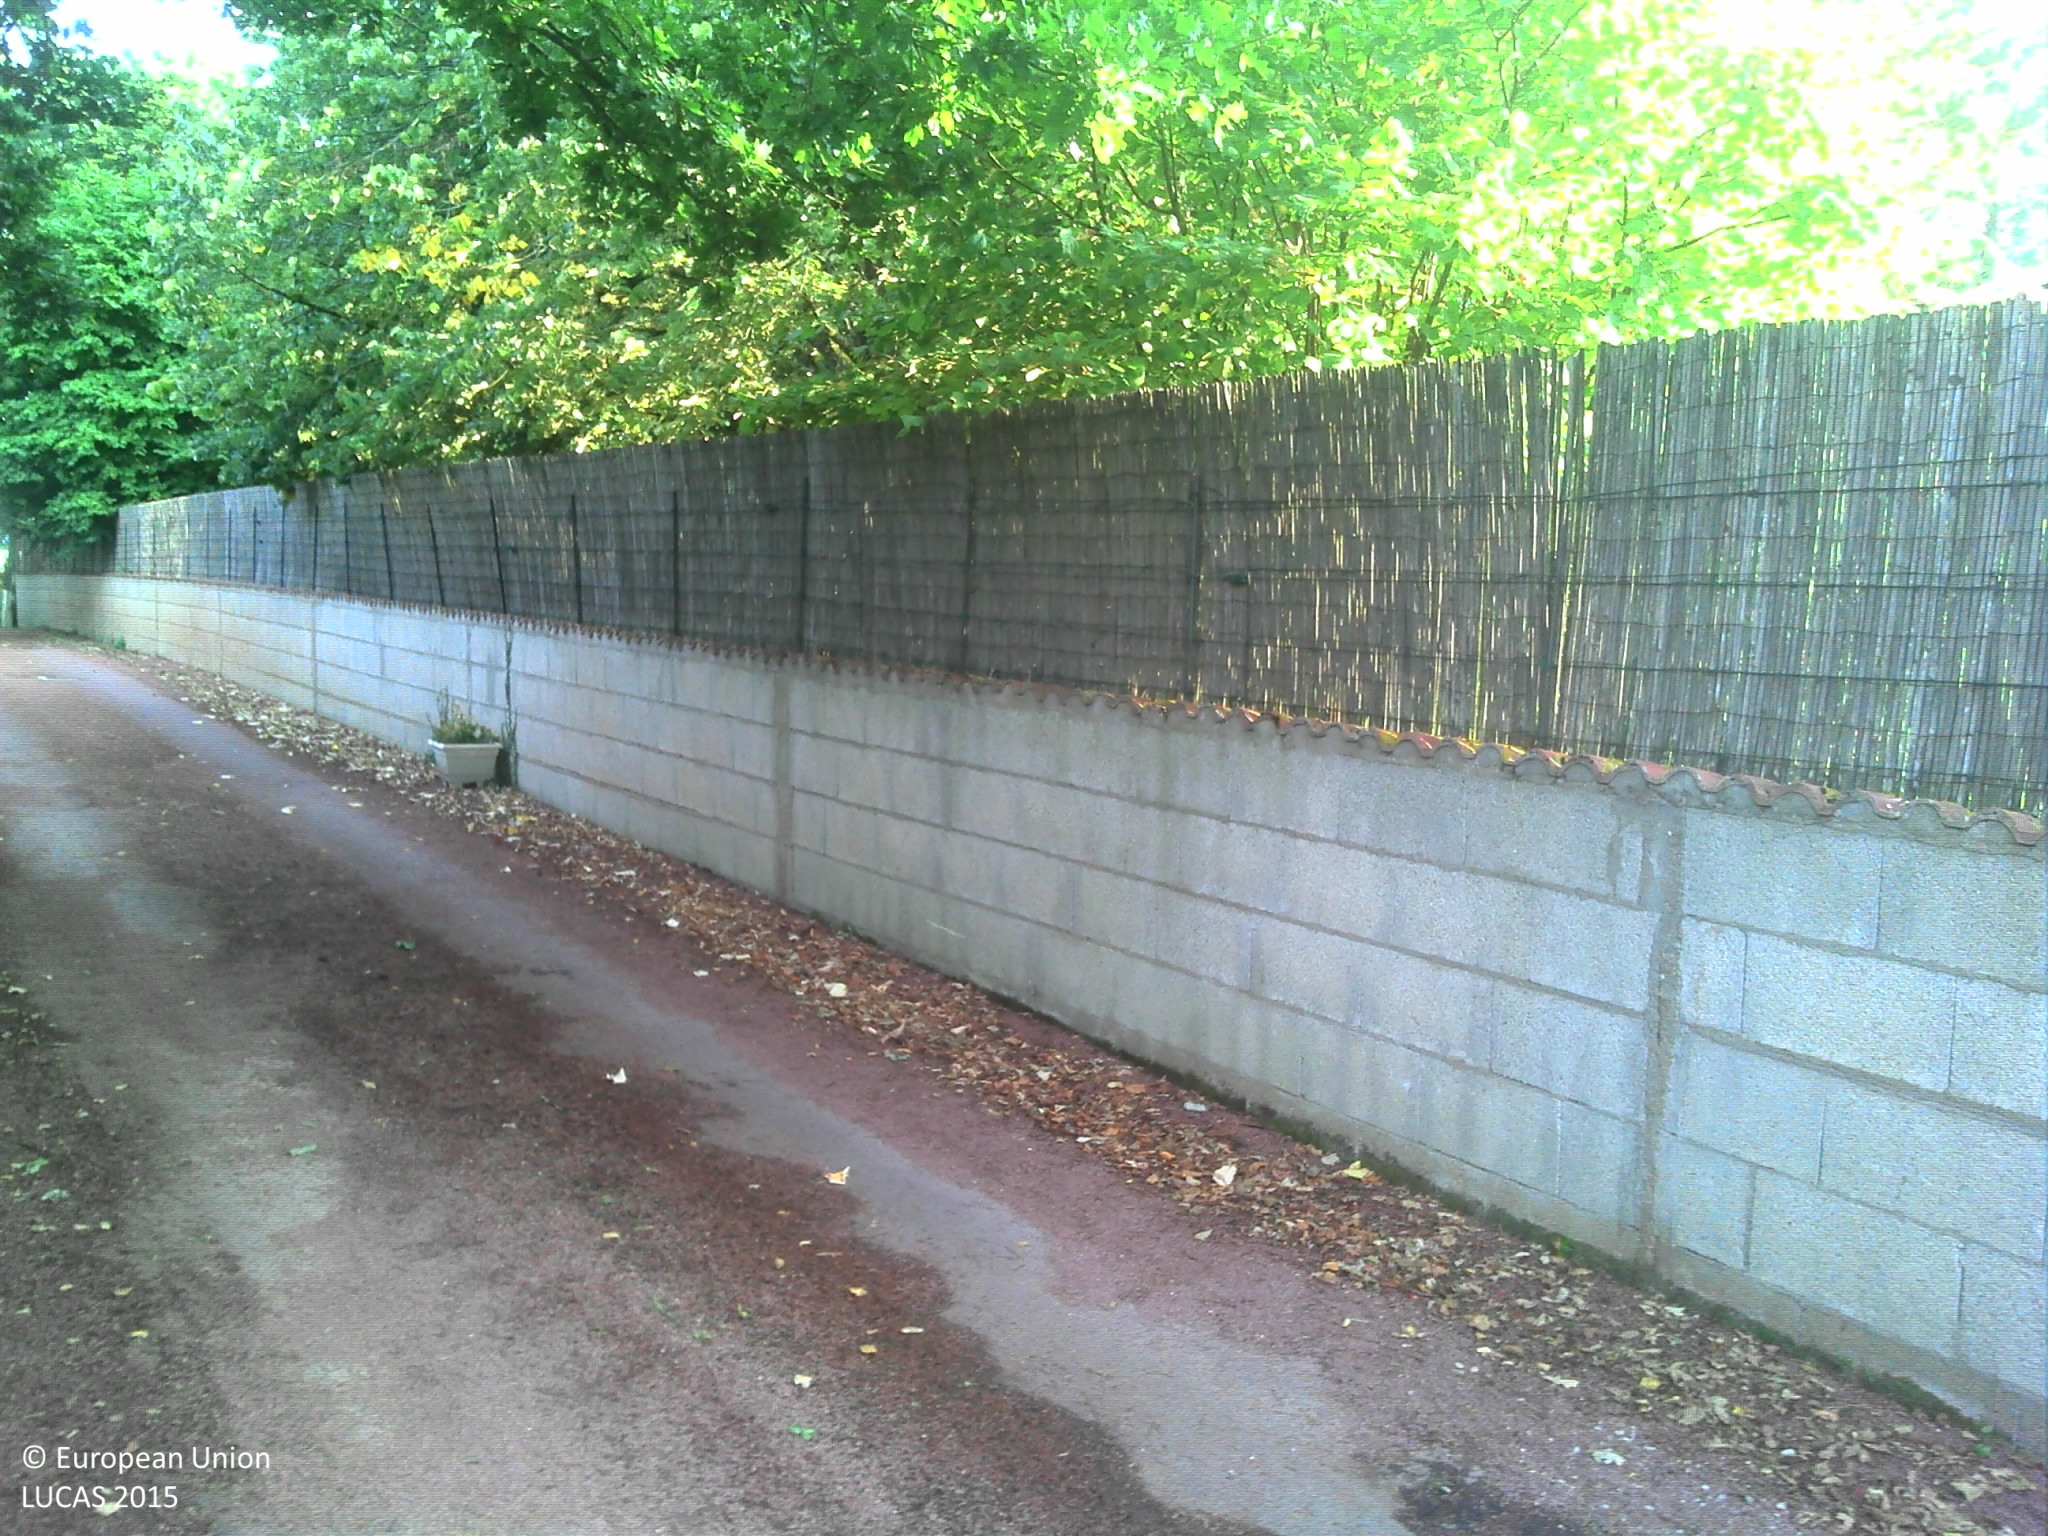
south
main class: Grassland
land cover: Grassland with sparse tree/shrub cover
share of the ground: > 75 %
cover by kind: herbaceous plants 95 %, broadleaved forest trees 5 %
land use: Residential
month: August
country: FR
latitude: 46.6467
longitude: -1.4175
